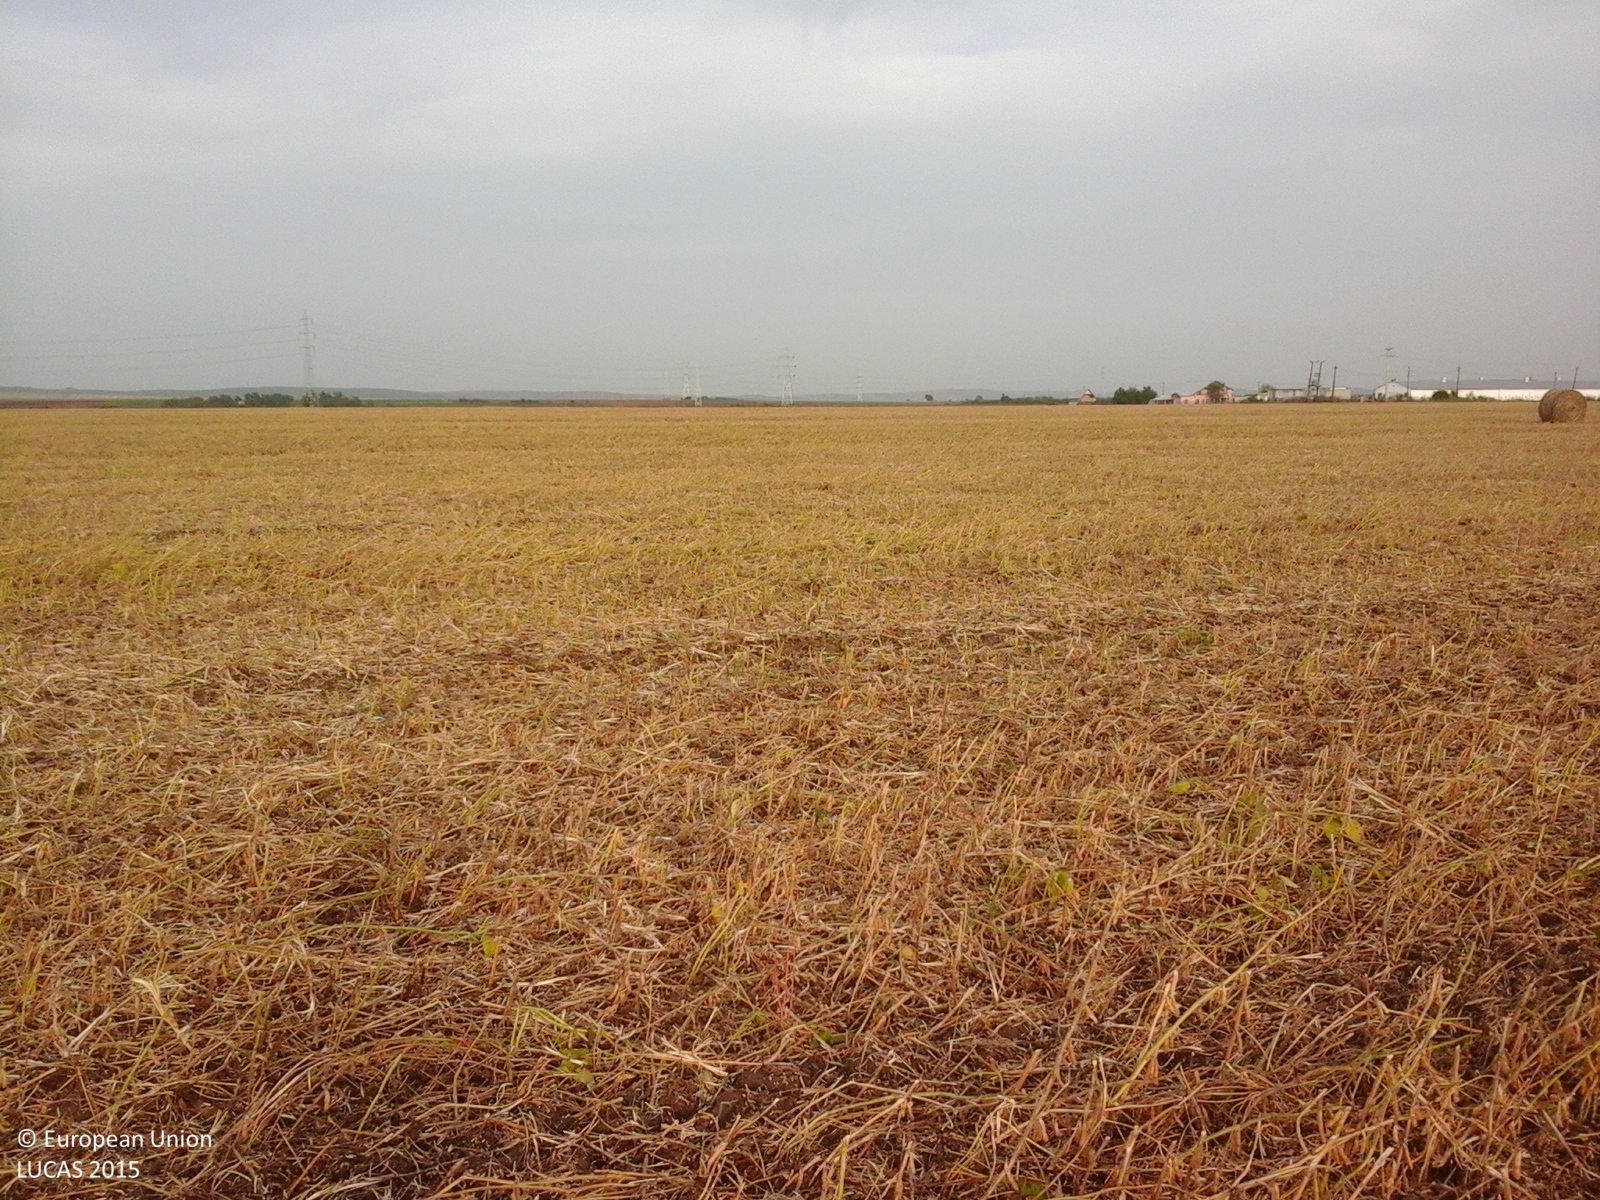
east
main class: Cropland
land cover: Soya
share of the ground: 50 - 75 %
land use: Agriculture (excluding fallow land and kitchen gardens)
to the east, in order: Soya
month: September
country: RO
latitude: 46.5817
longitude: 23.8154
